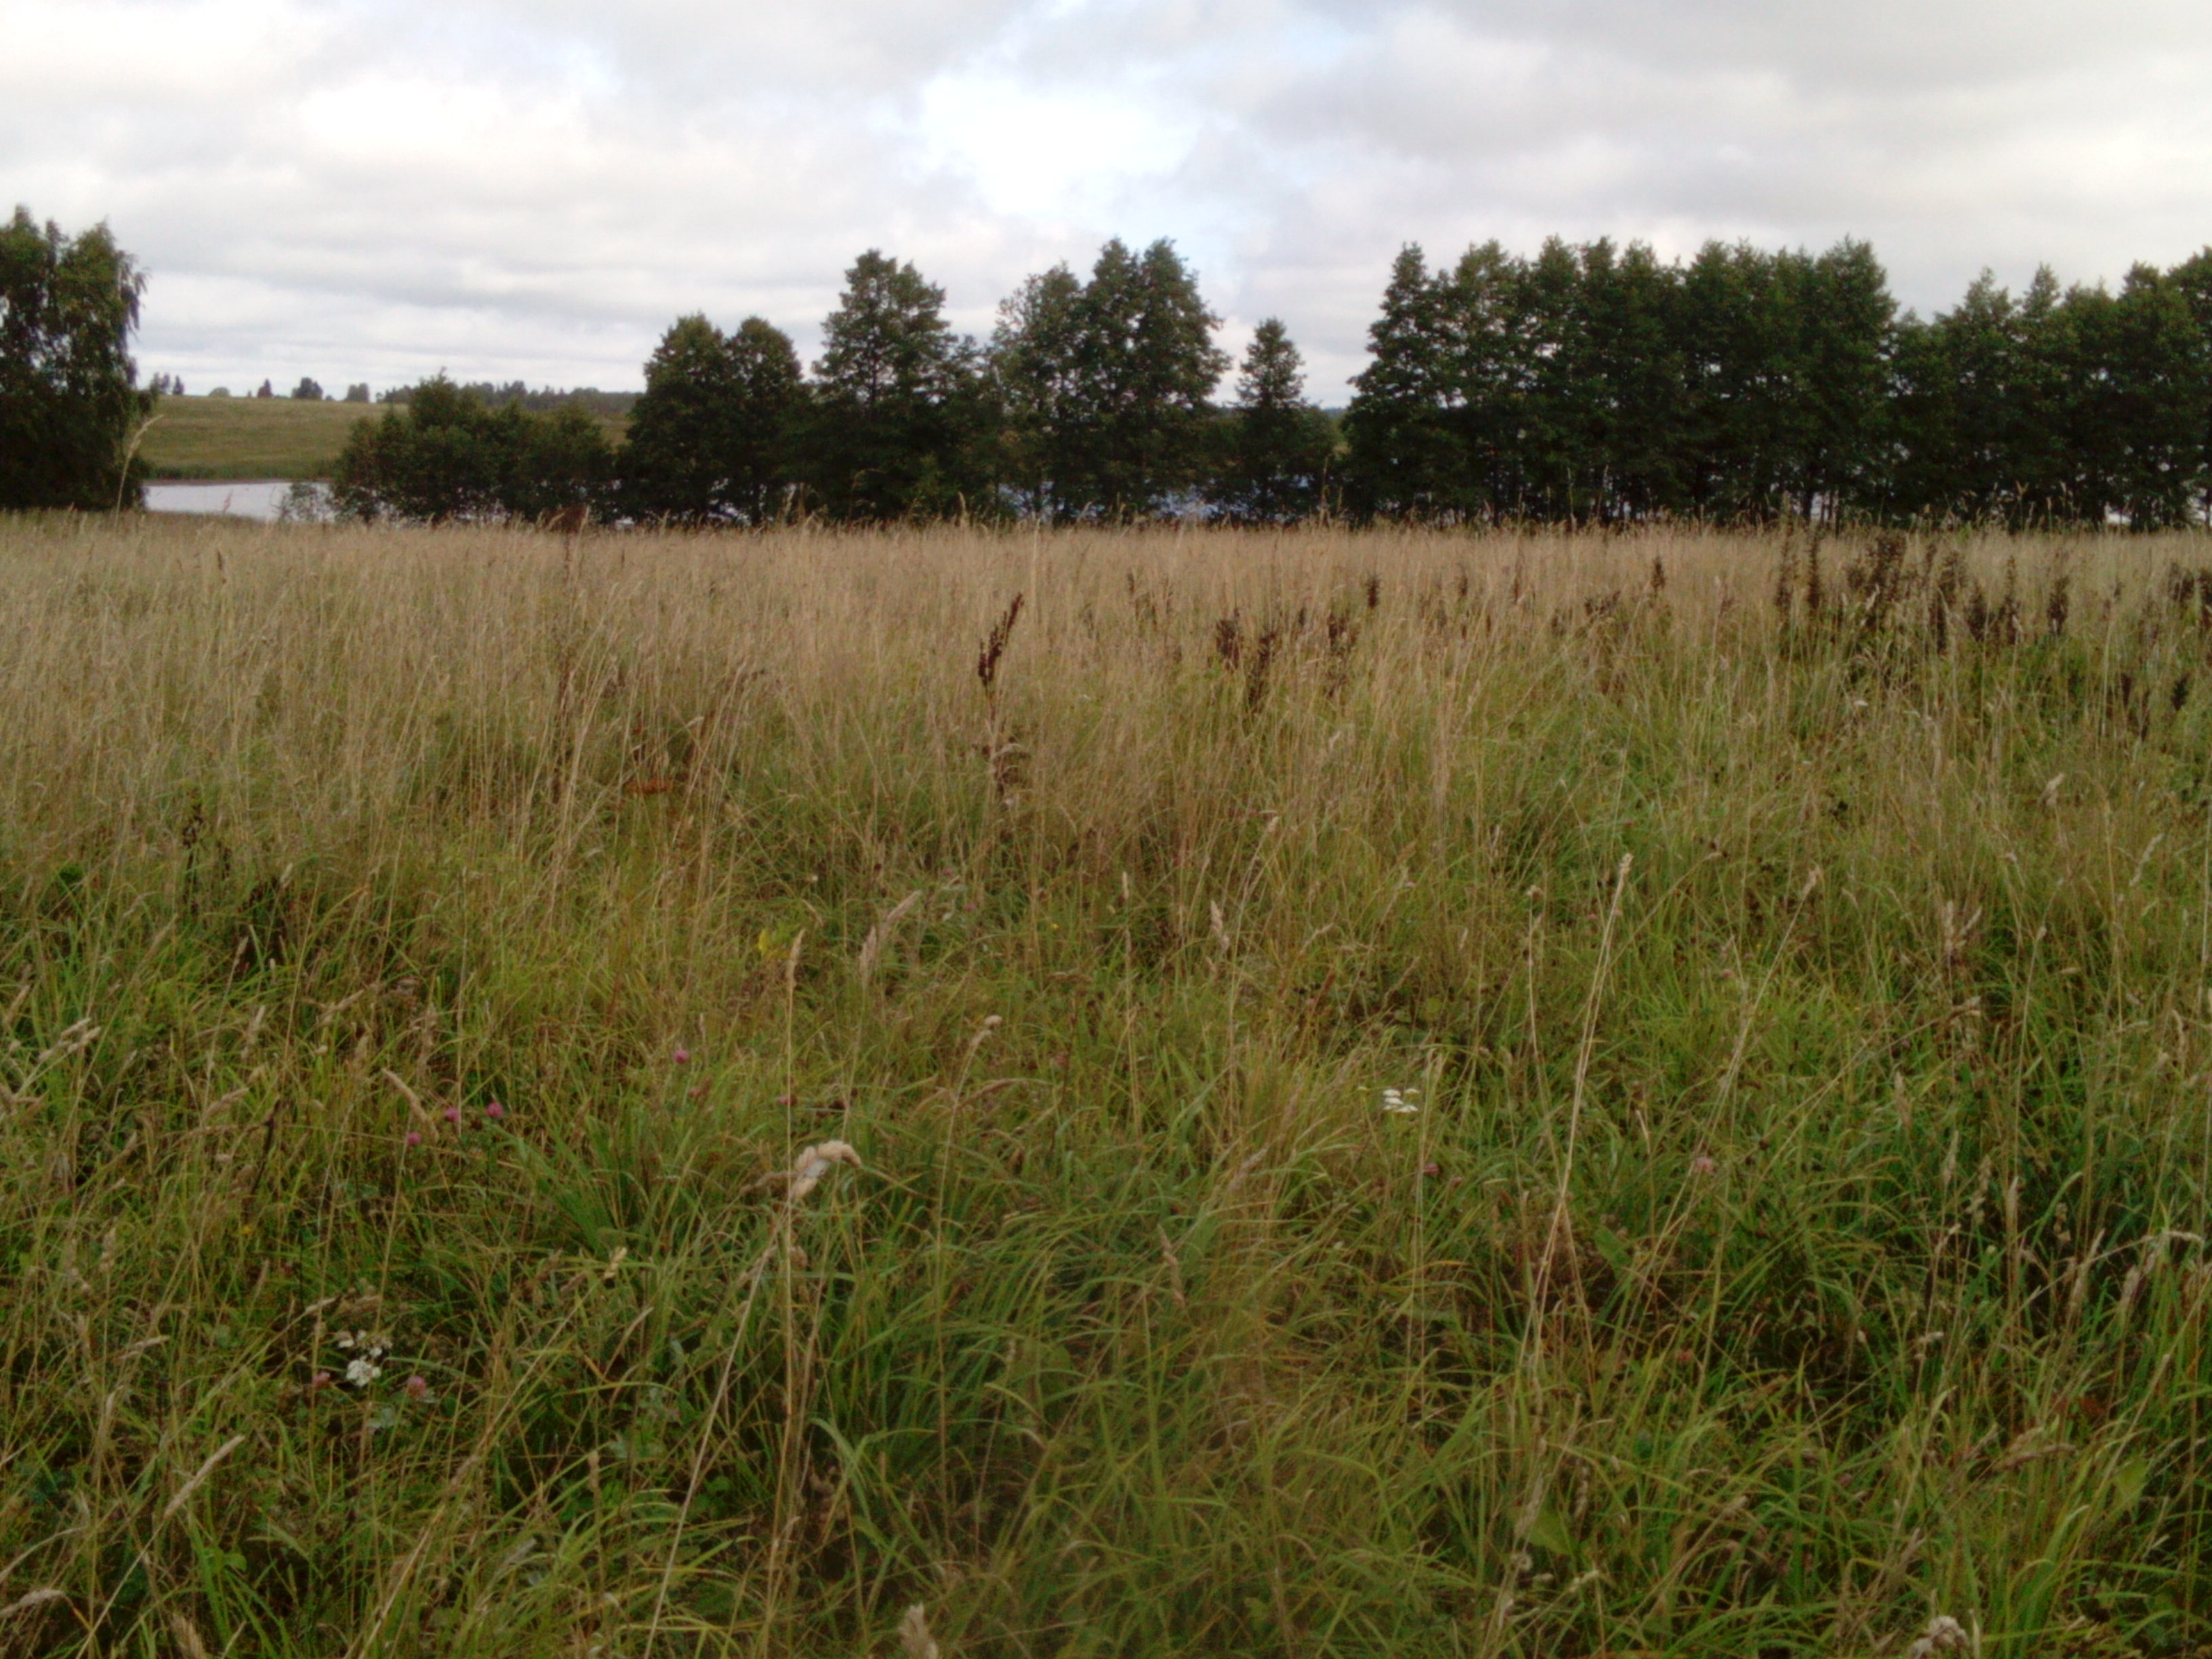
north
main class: Grassland
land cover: Grassland without tree/shrub cover
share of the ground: > 75 %
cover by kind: herbaceous plants 100 %
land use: Agriculture (excluding fallow land and kitchen gardens)
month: September
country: LT
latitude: 55.9450
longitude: 22.7939
